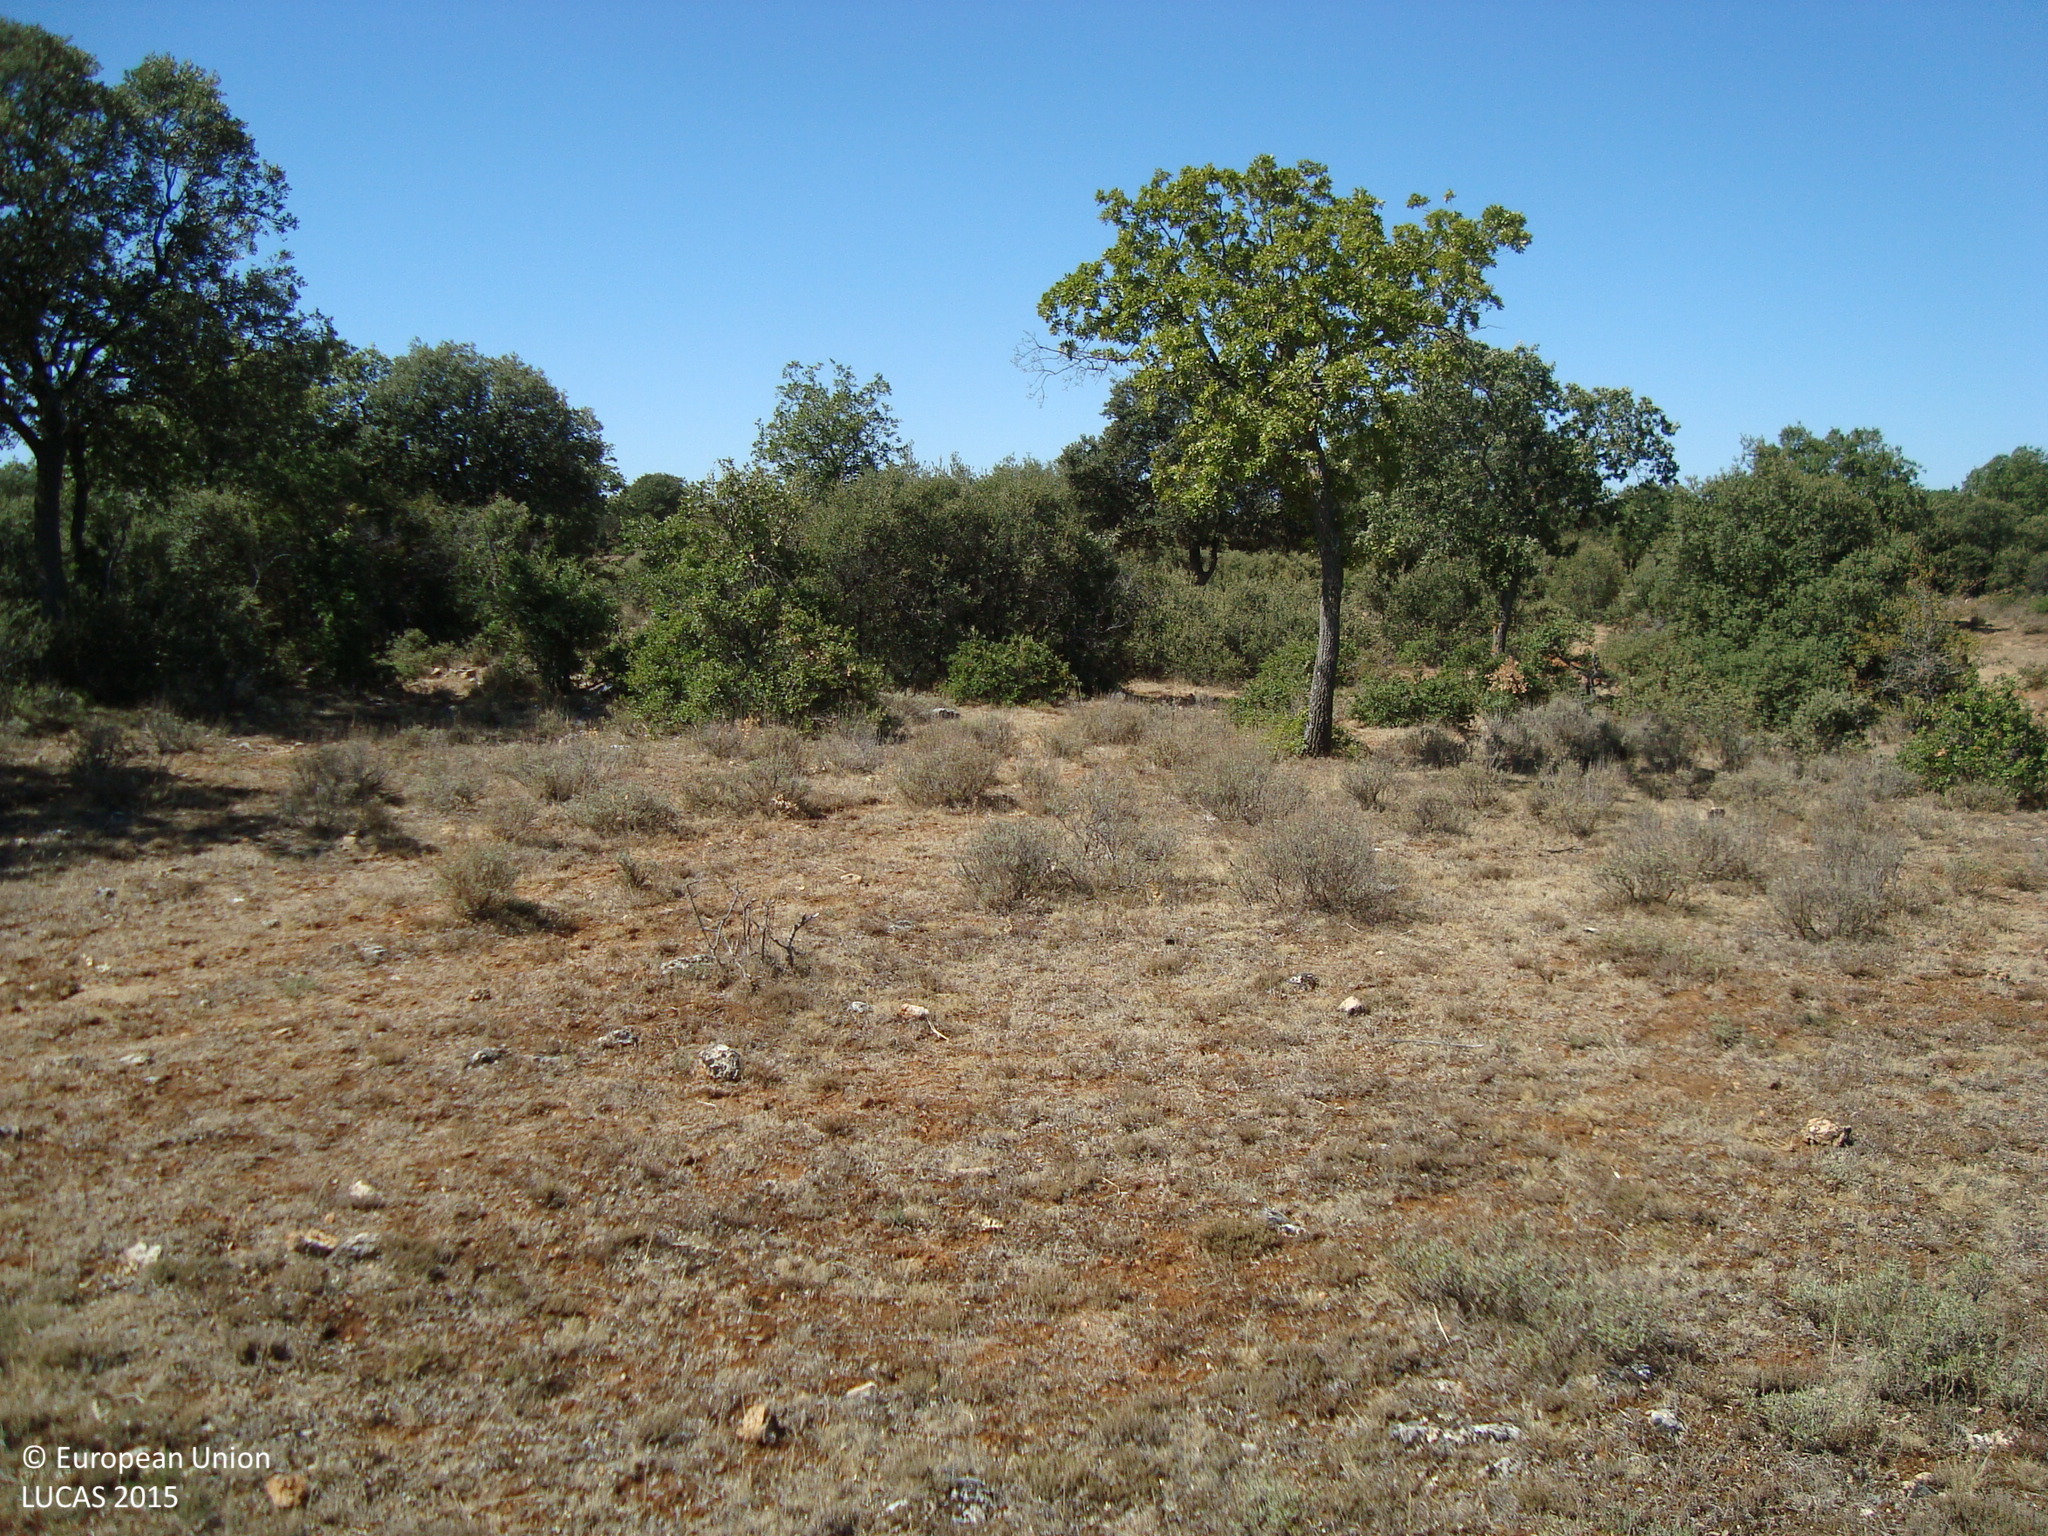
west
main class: Woodland
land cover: Broadleaved woodland
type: broadleaved evergreen forest
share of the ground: 50 - 75 %
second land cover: Grassland without tree/shrub cover
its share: > 75 %
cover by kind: broadleaved forest trees 50 %, shrubs 20 %, herbaceous plants 20 %, unconsolidated bare surface 10 %
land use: Forestry
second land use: Agriculture (excluding fallow land and kitchen gardens)
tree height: > 5 m
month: August
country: ES
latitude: 42.1127
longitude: -4.2777
